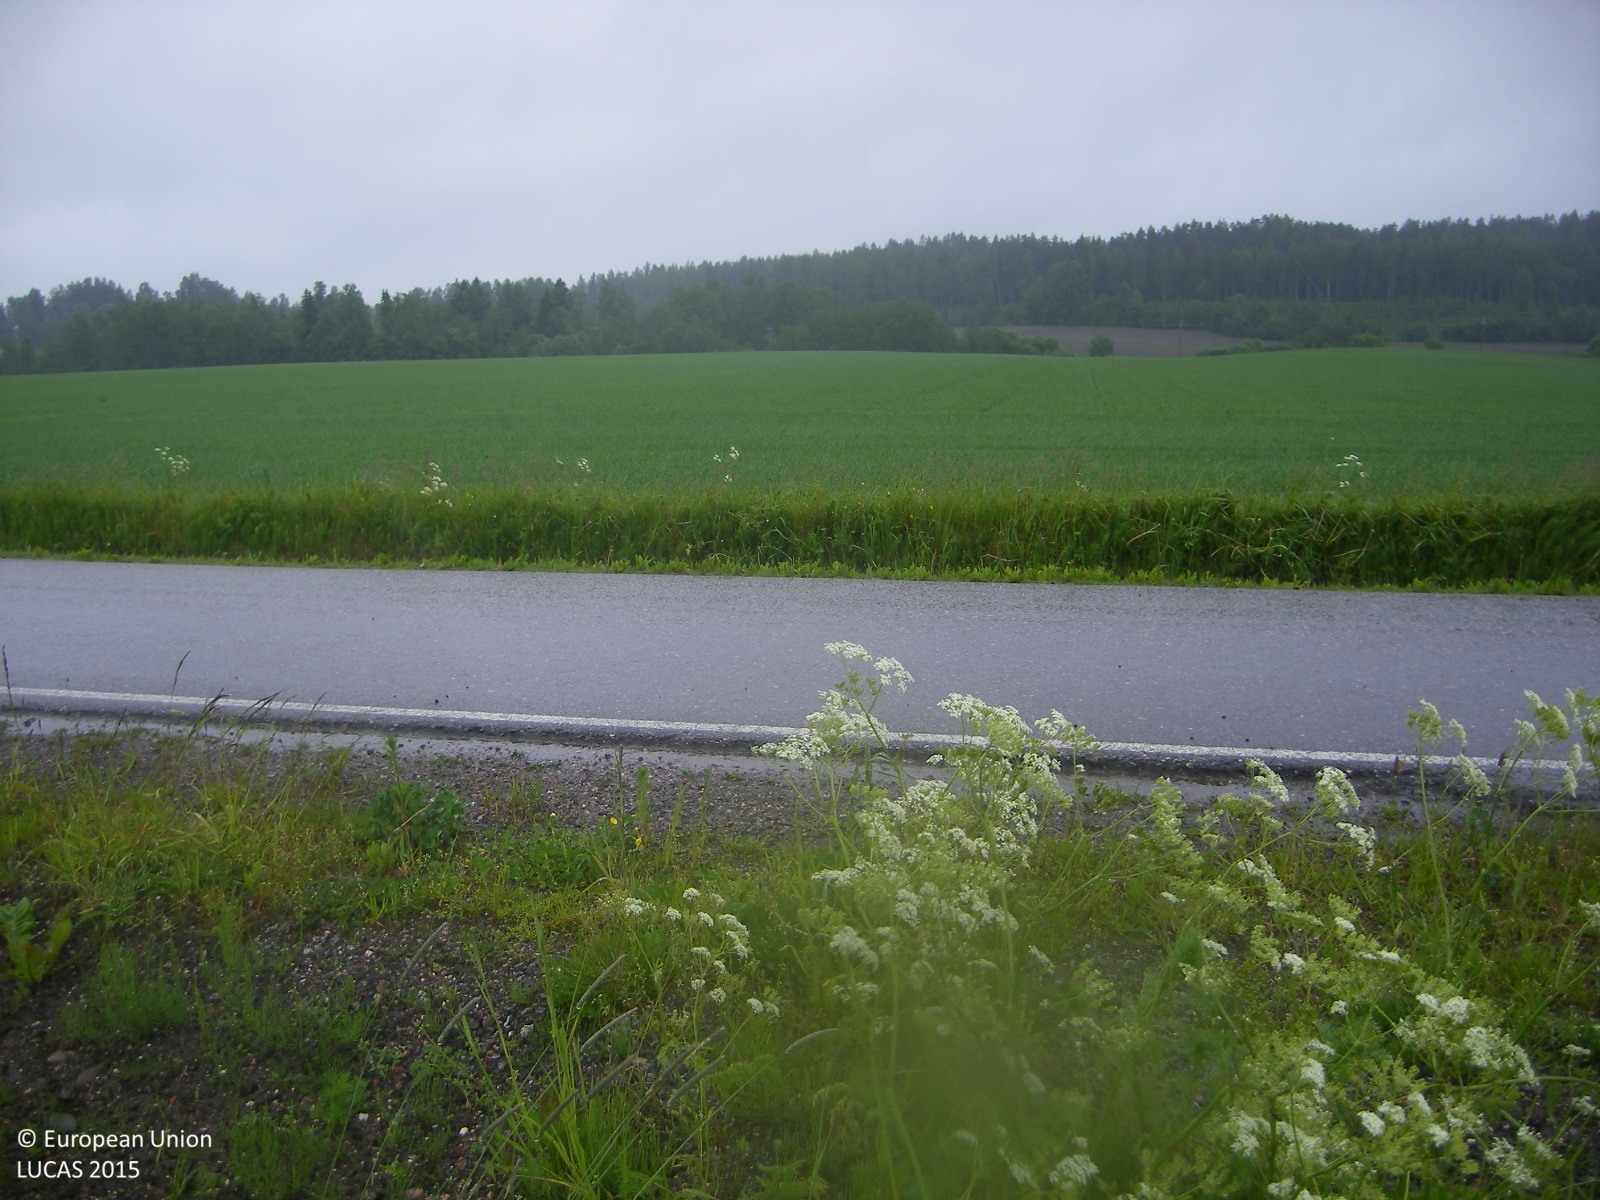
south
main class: Cropland
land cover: Clovers
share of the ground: > 75 %
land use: Agriculture (excluding fallow land and kitchen gardens)
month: June
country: FI
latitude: 60.1040
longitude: 24.1494
